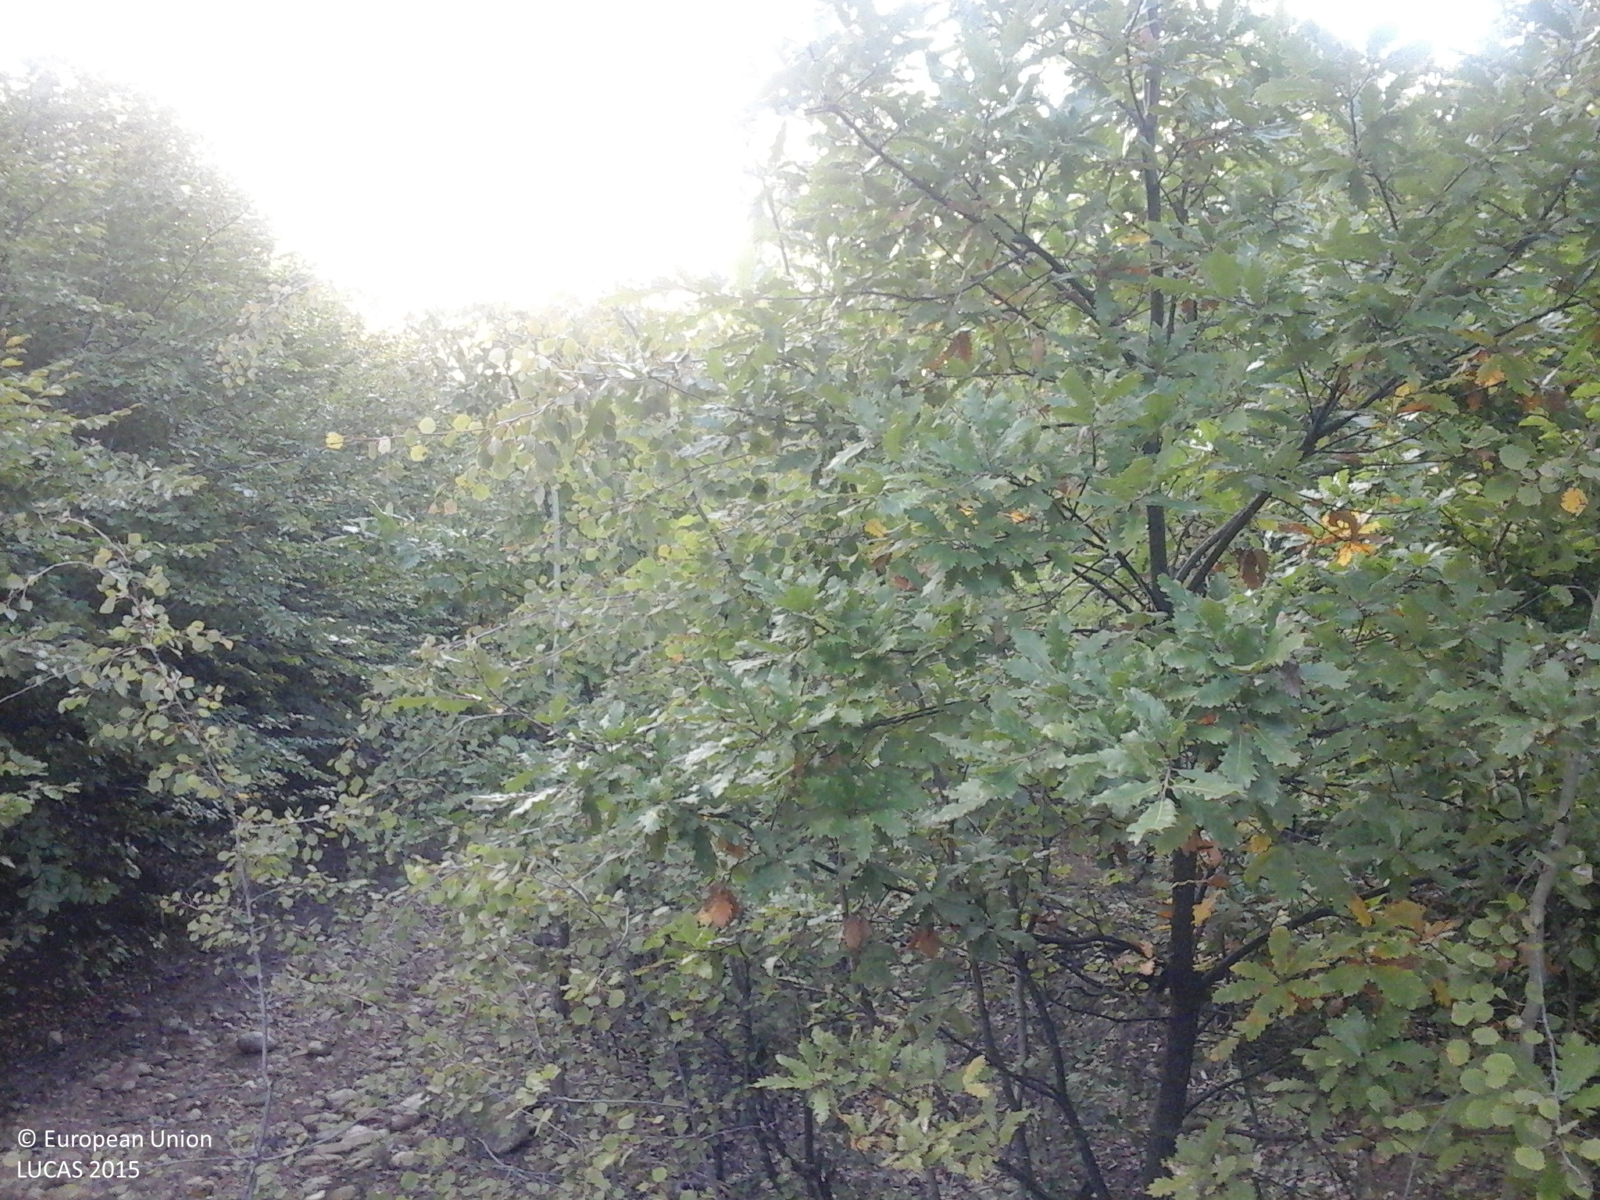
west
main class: Woodland
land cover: Broadleaved woodland
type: mesophytic deciduous forest
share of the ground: > 75 %
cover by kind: broadleaved forest trees 100 %
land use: Forestry
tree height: > 5 m
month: September
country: RO
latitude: 45.0566
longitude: 23.6087
